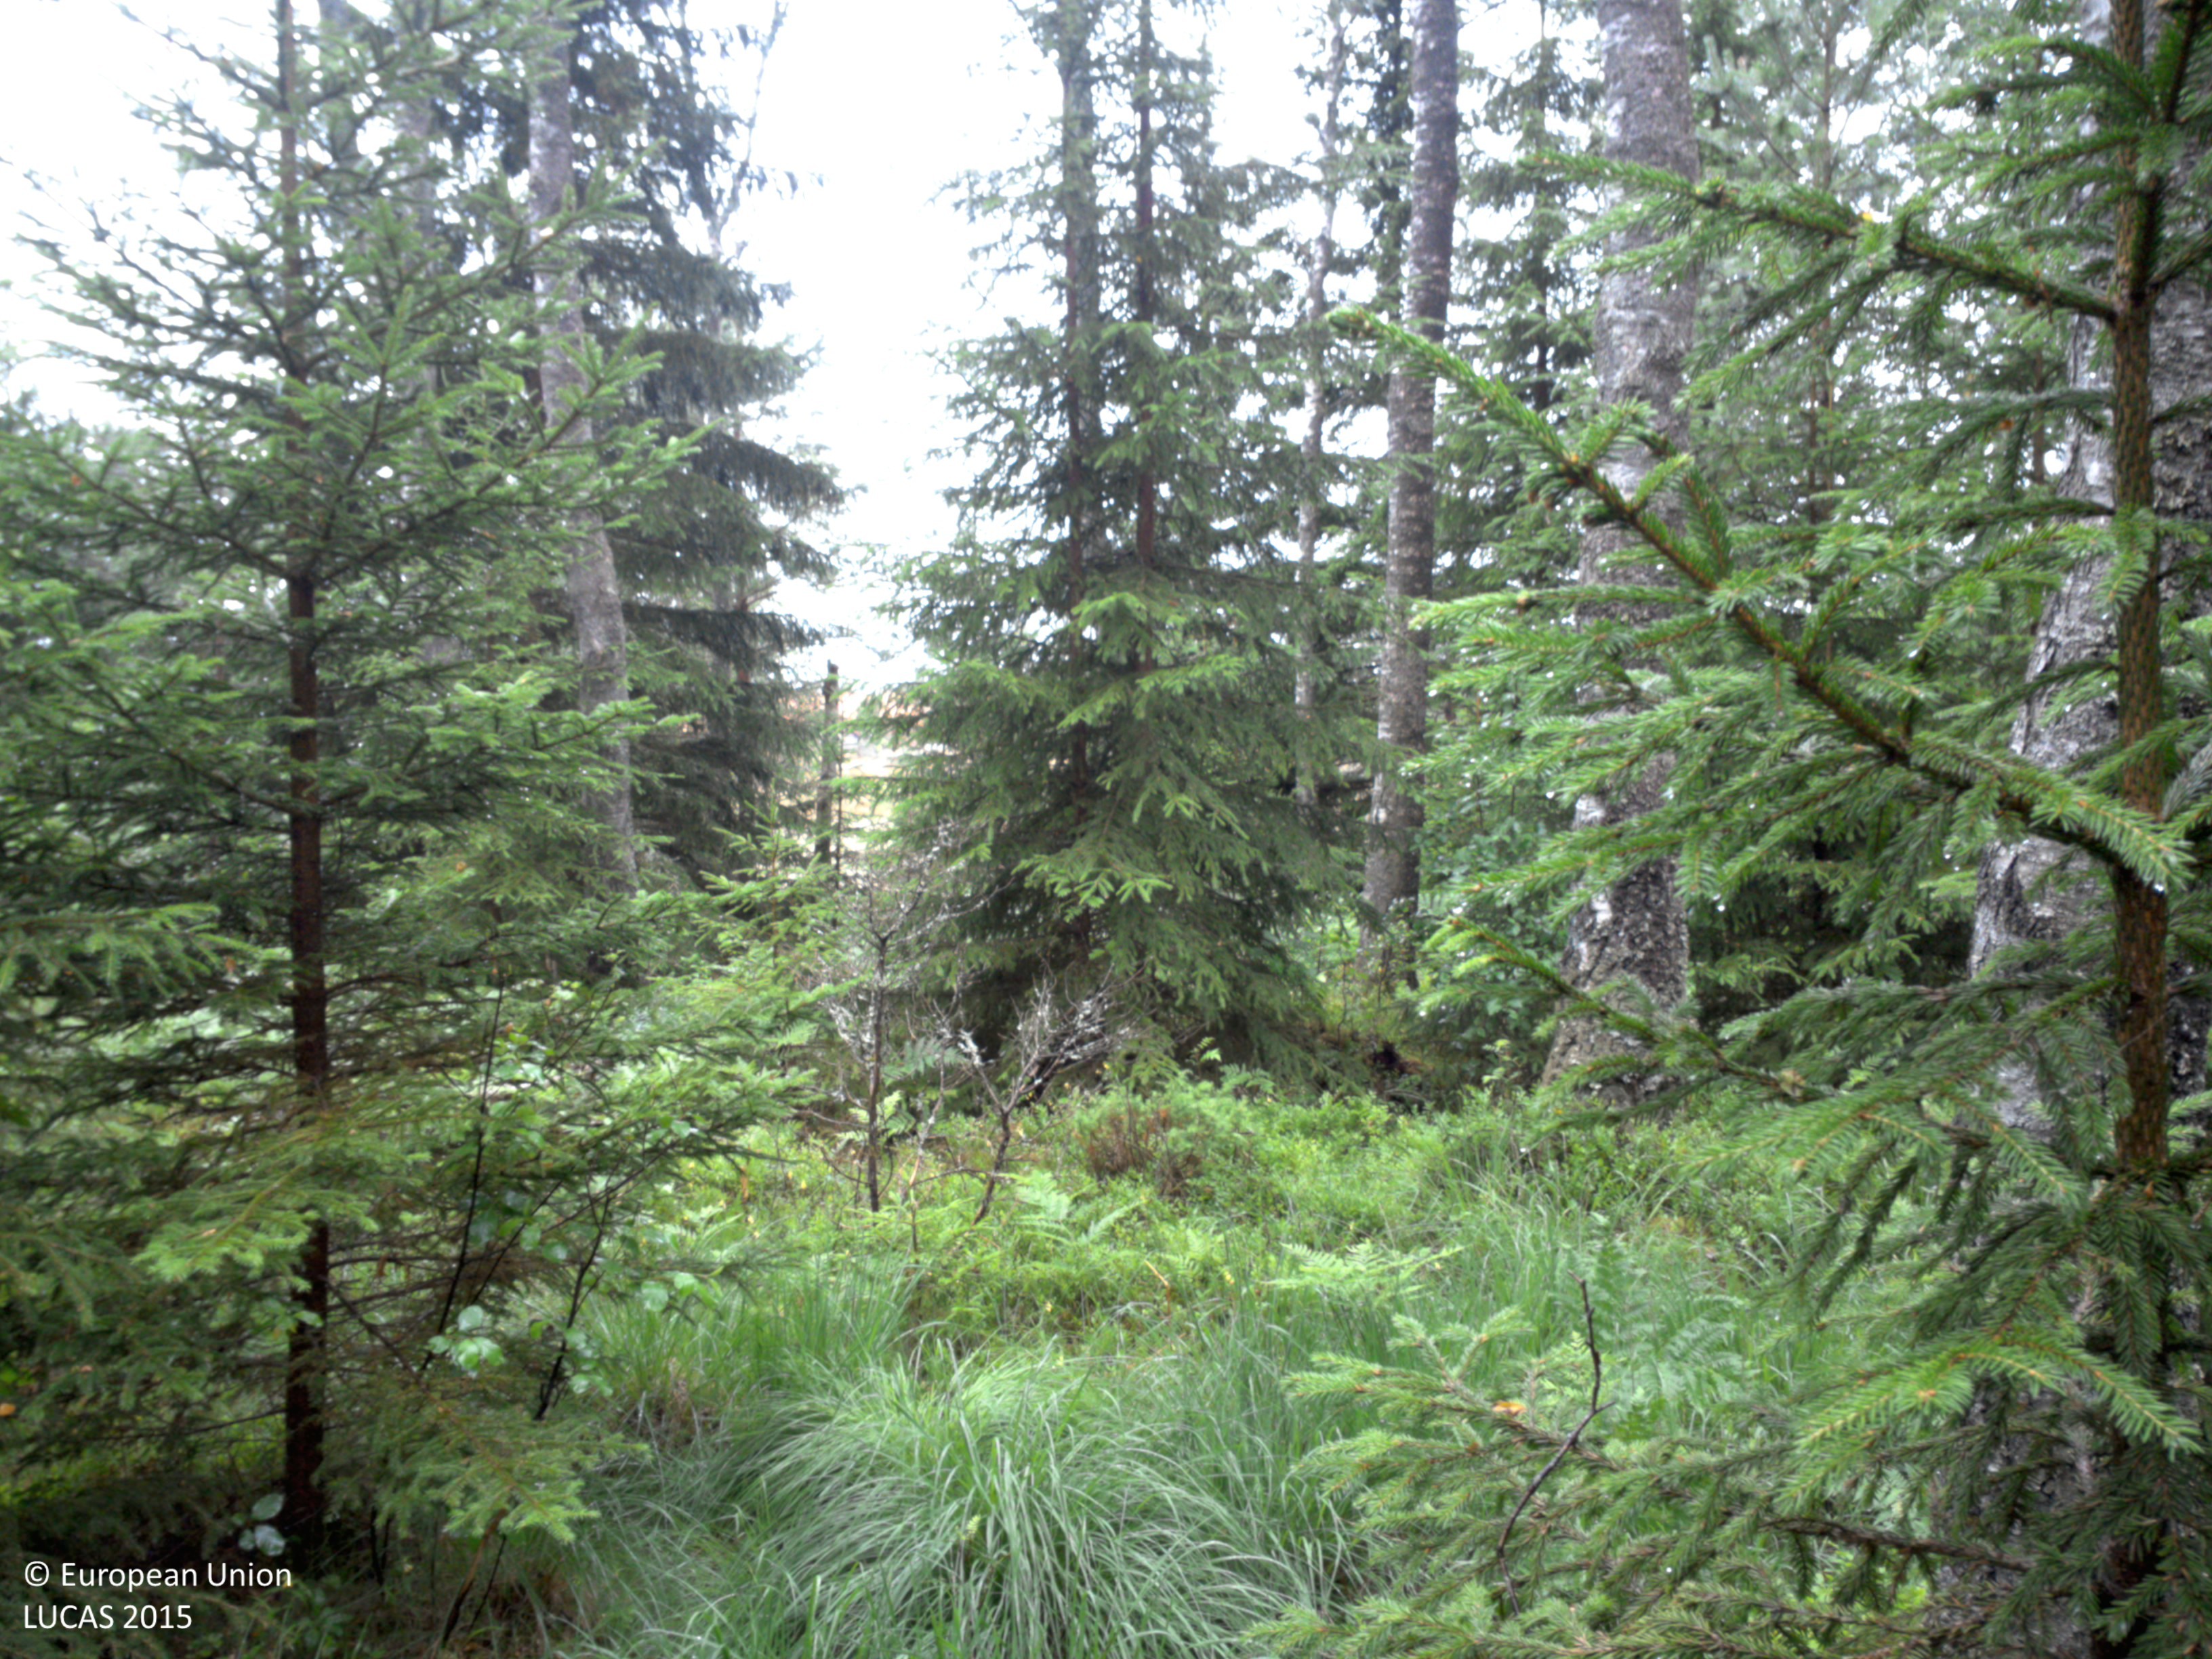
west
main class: Woodland
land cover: Spruce dominated mixed woodland
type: boreal forest
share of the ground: > 75 %
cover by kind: coniferous forest trees 60 %, broadleaved forest trees 25 %, herbaceous plants 15 %
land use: Forestry
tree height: > 5 m
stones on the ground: < 10 %
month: July
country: SE
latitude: 58.6413
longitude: 11.6331
